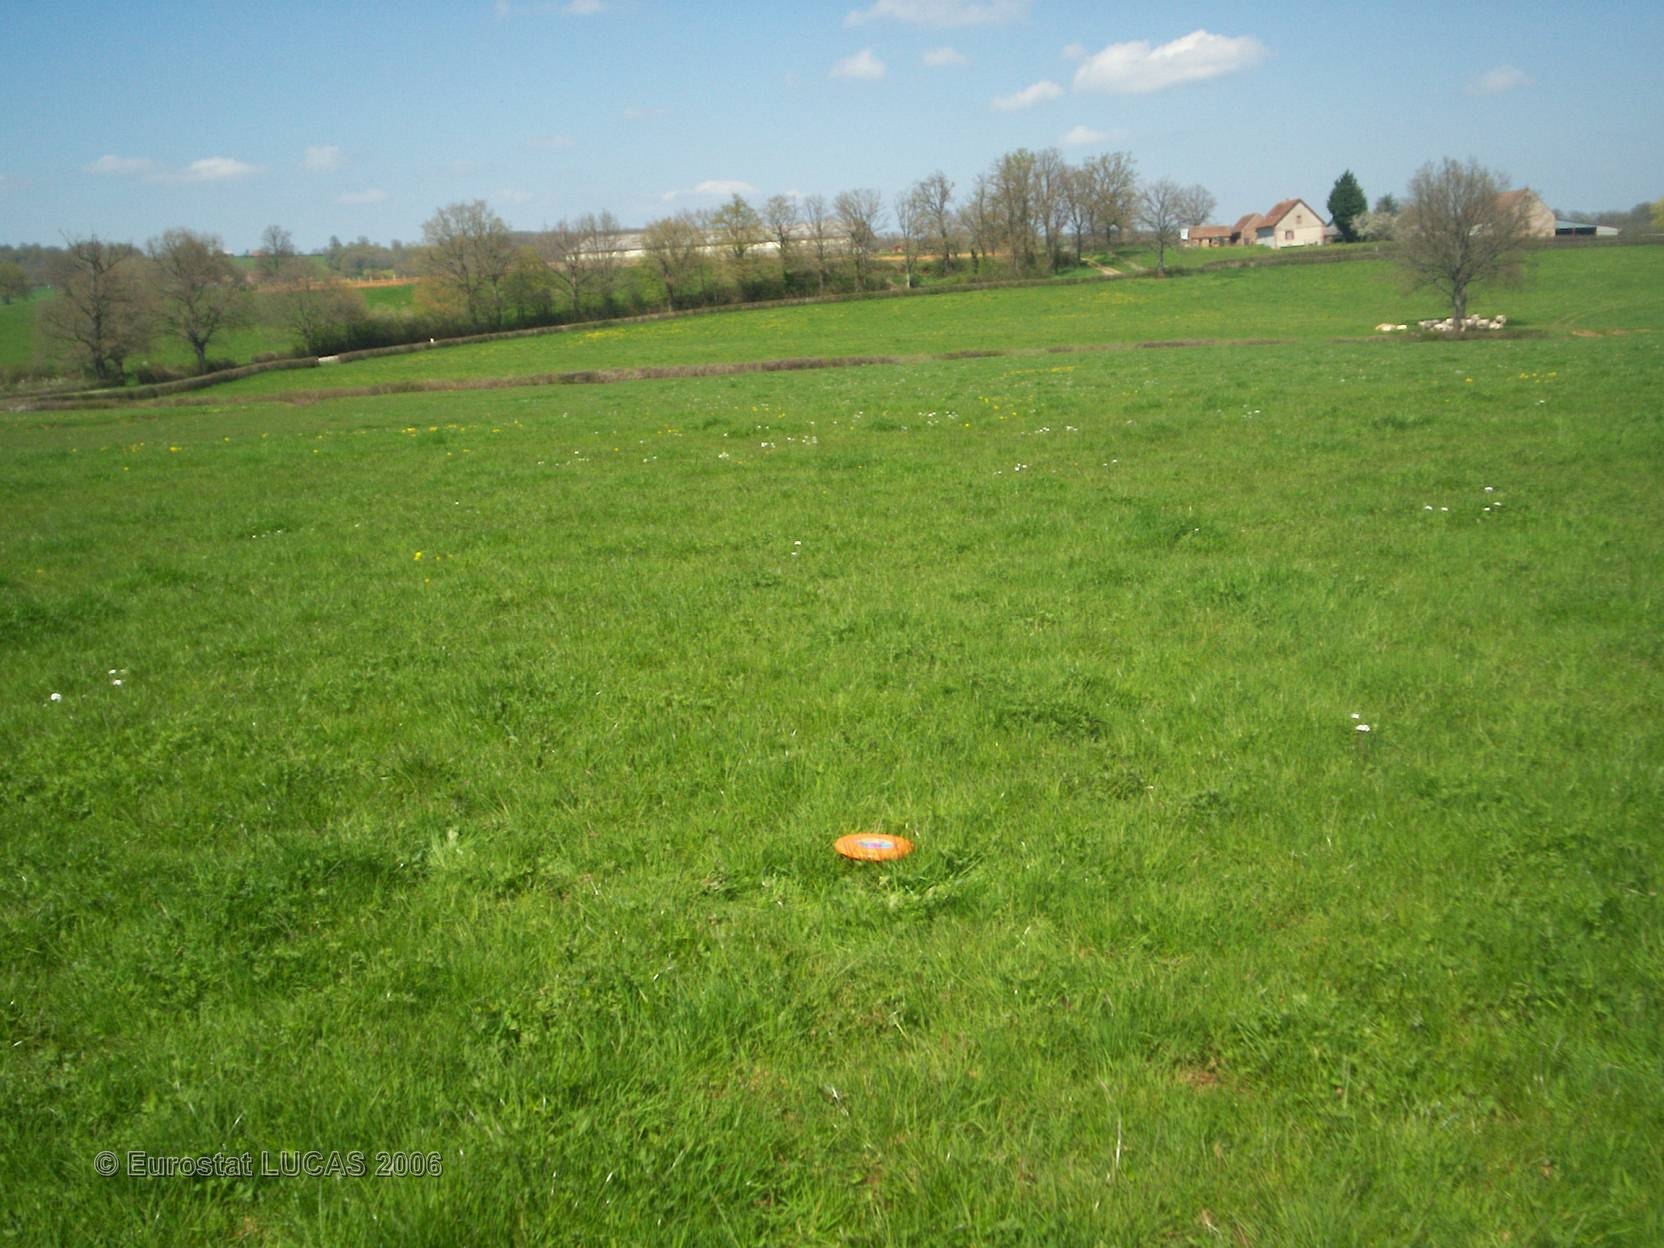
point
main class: Grassland
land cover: Grassland without tree/shrub cover
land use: Agriculture (excluding fallow land and kitchen gardens)
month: April
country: FR
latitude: 46.6514
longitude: 3.0848
